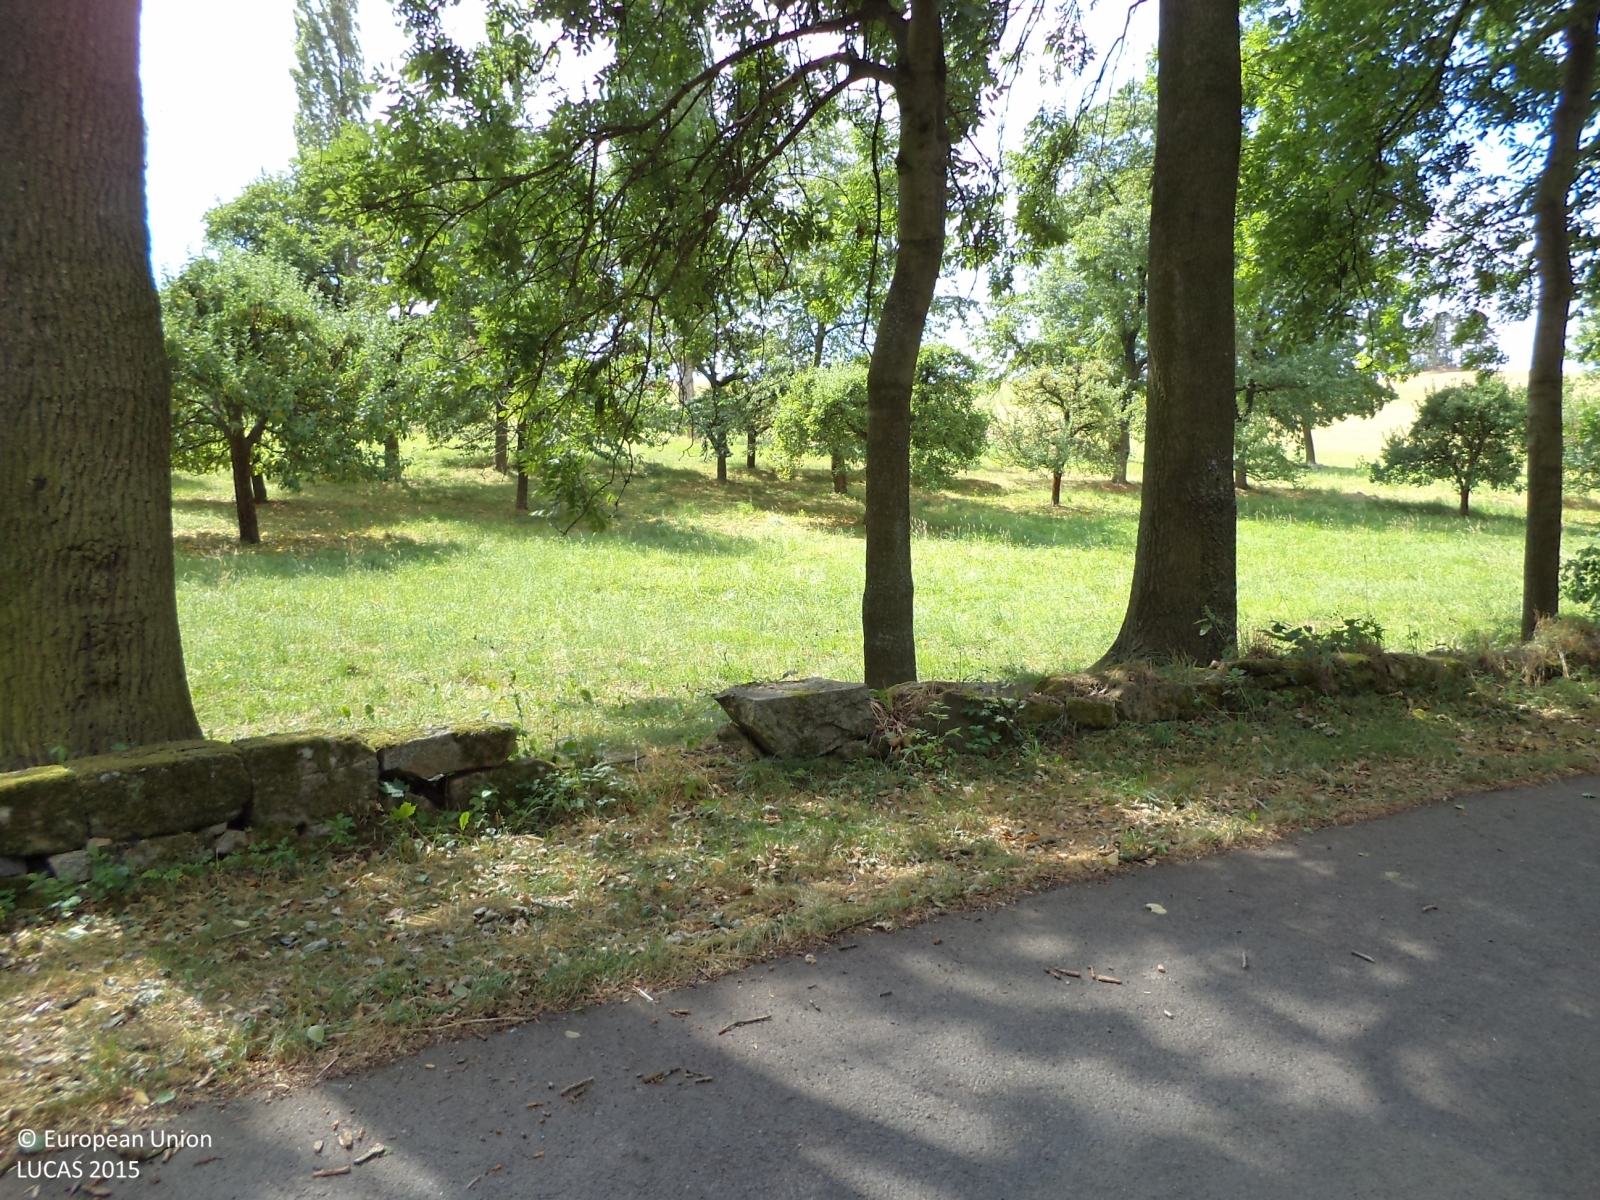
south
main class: Woodland
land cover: Broadleaved woodland
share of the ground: > 75 %
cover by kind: broadleaved forest trees 90 %, herbaceous plants 10 %
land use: Forestry
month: July
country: CZ
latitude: 49.6652
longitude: 14.4489
